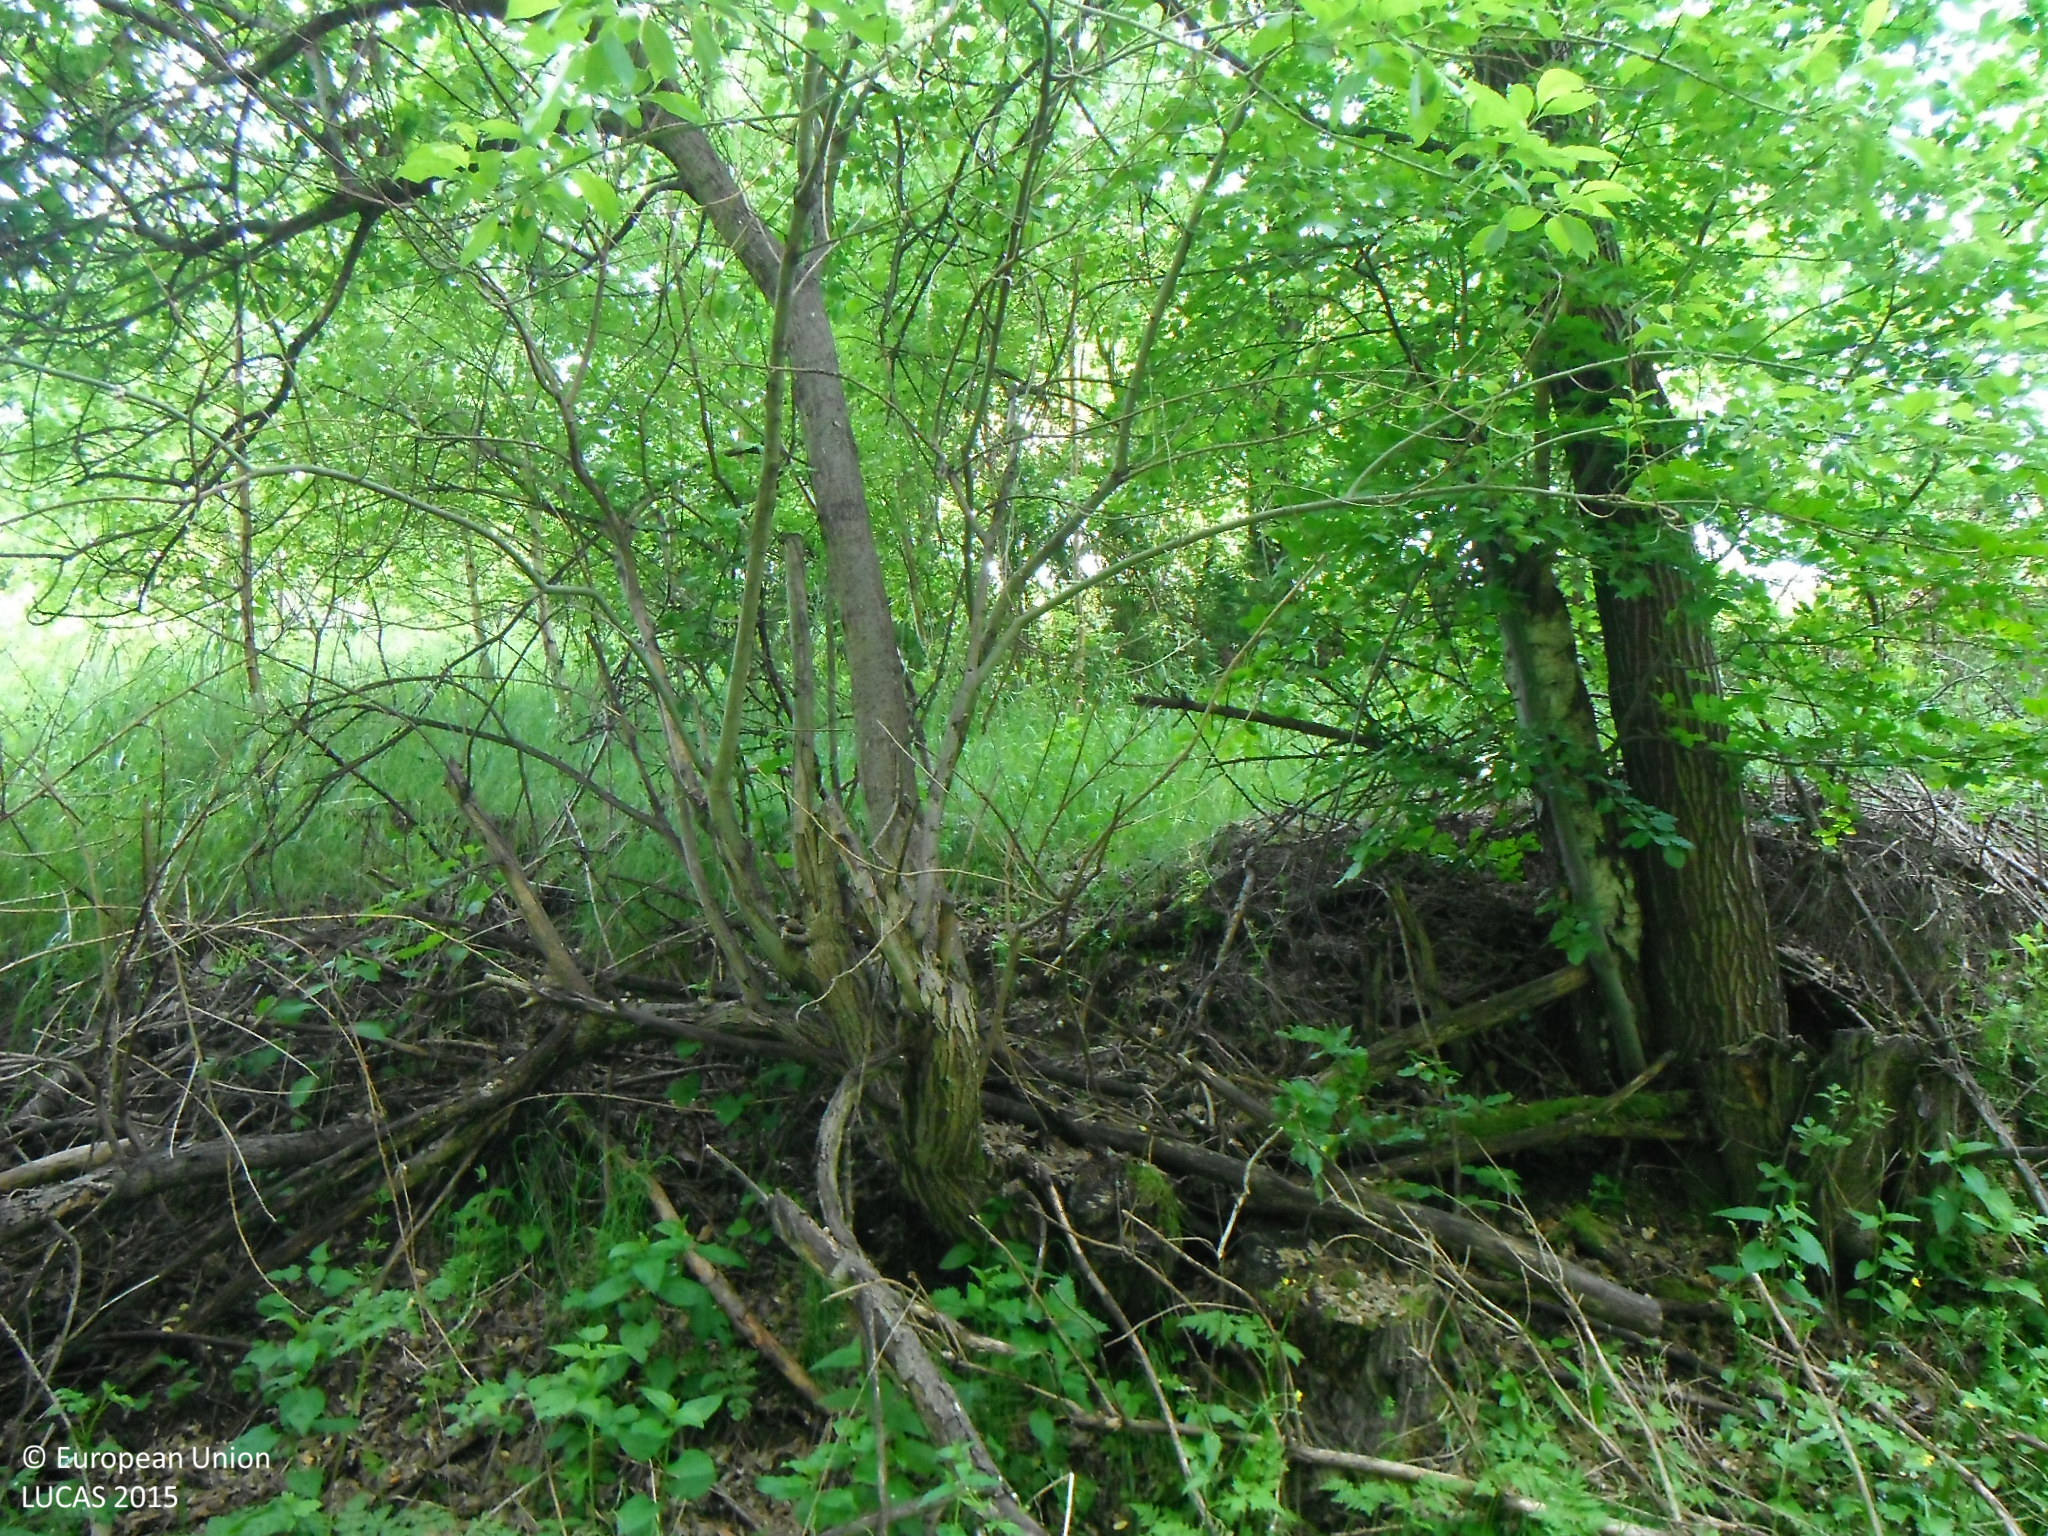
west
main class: Woodland
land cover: Broadleaved woodland
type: mesophytic deciduous forest
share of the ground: > 75 %
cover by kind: broadleaved forest trees 80 %, herbaceous plants 20 %
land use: Forestry
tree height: > 5 m
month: May
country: SK
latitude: 48.5331
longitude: 19.5457
